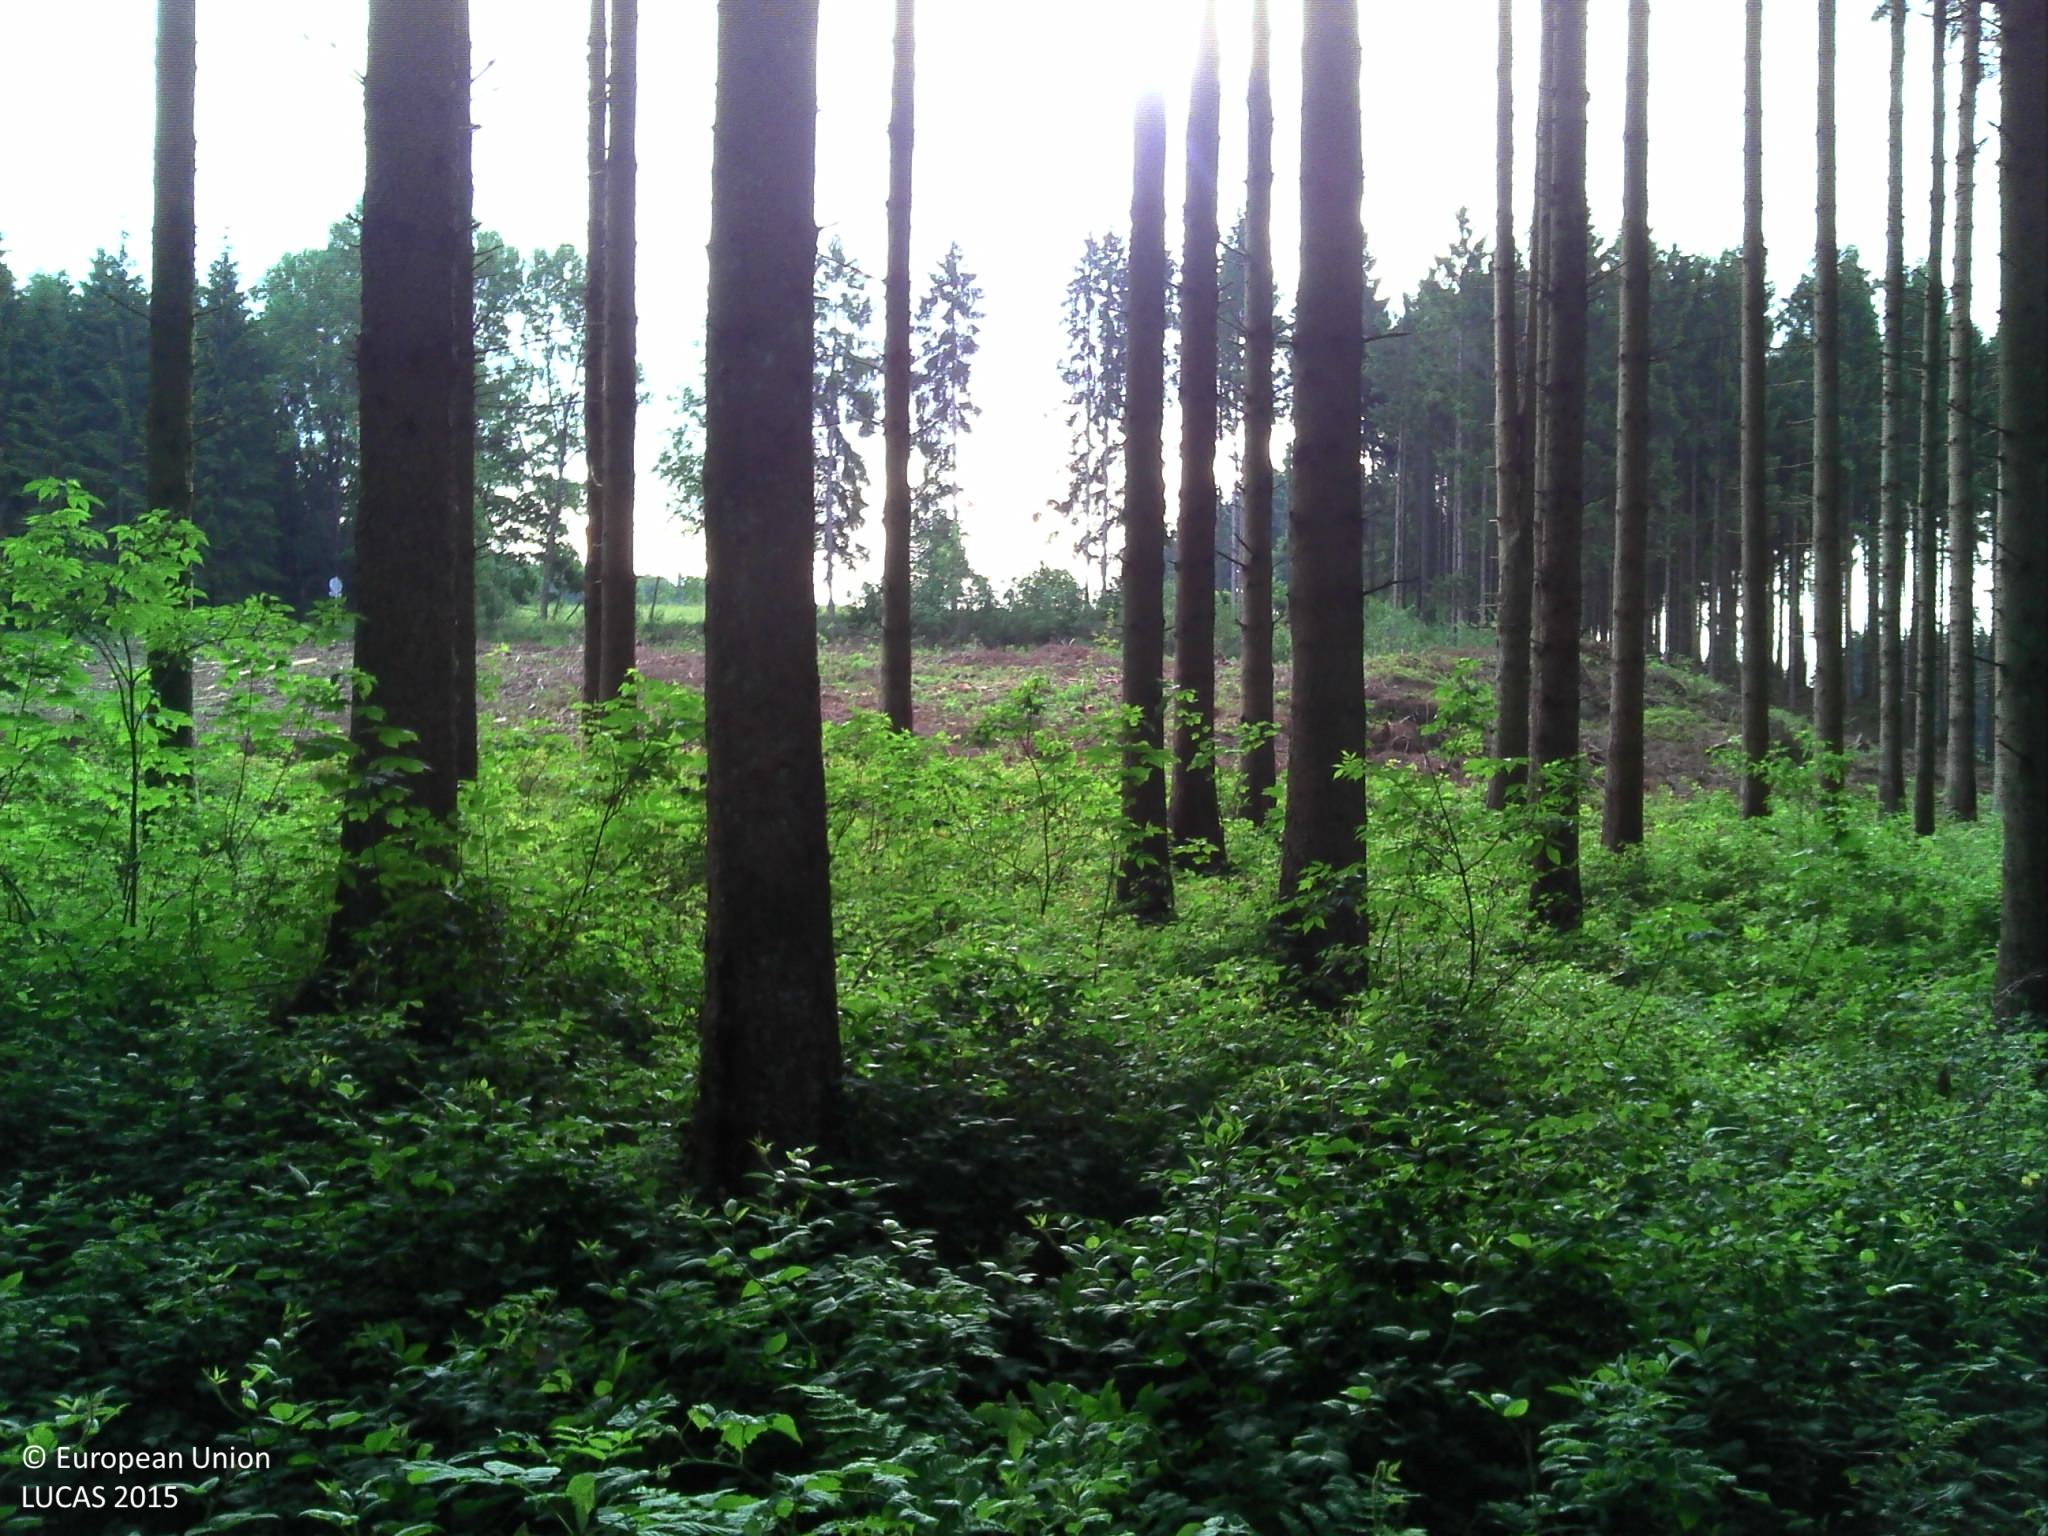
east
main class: Woodland
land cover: Spruce dominated coniferous woodland
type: alpine coniferous forest
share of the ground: > 75 %
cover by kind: coniferous forest trees 95 %, herbaceous plants 5 %
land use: Forestry
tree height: > 5 m
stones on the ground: < 10 %
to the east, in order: Spruce dominated coniferous woodland; Other bare soil; Paved roads, cycling and walking lanes; Spruce dominated coniferous woodland; Spontaneously vegetated surfaces
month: June
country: BE
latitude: 49.9746
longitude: 5.1871
